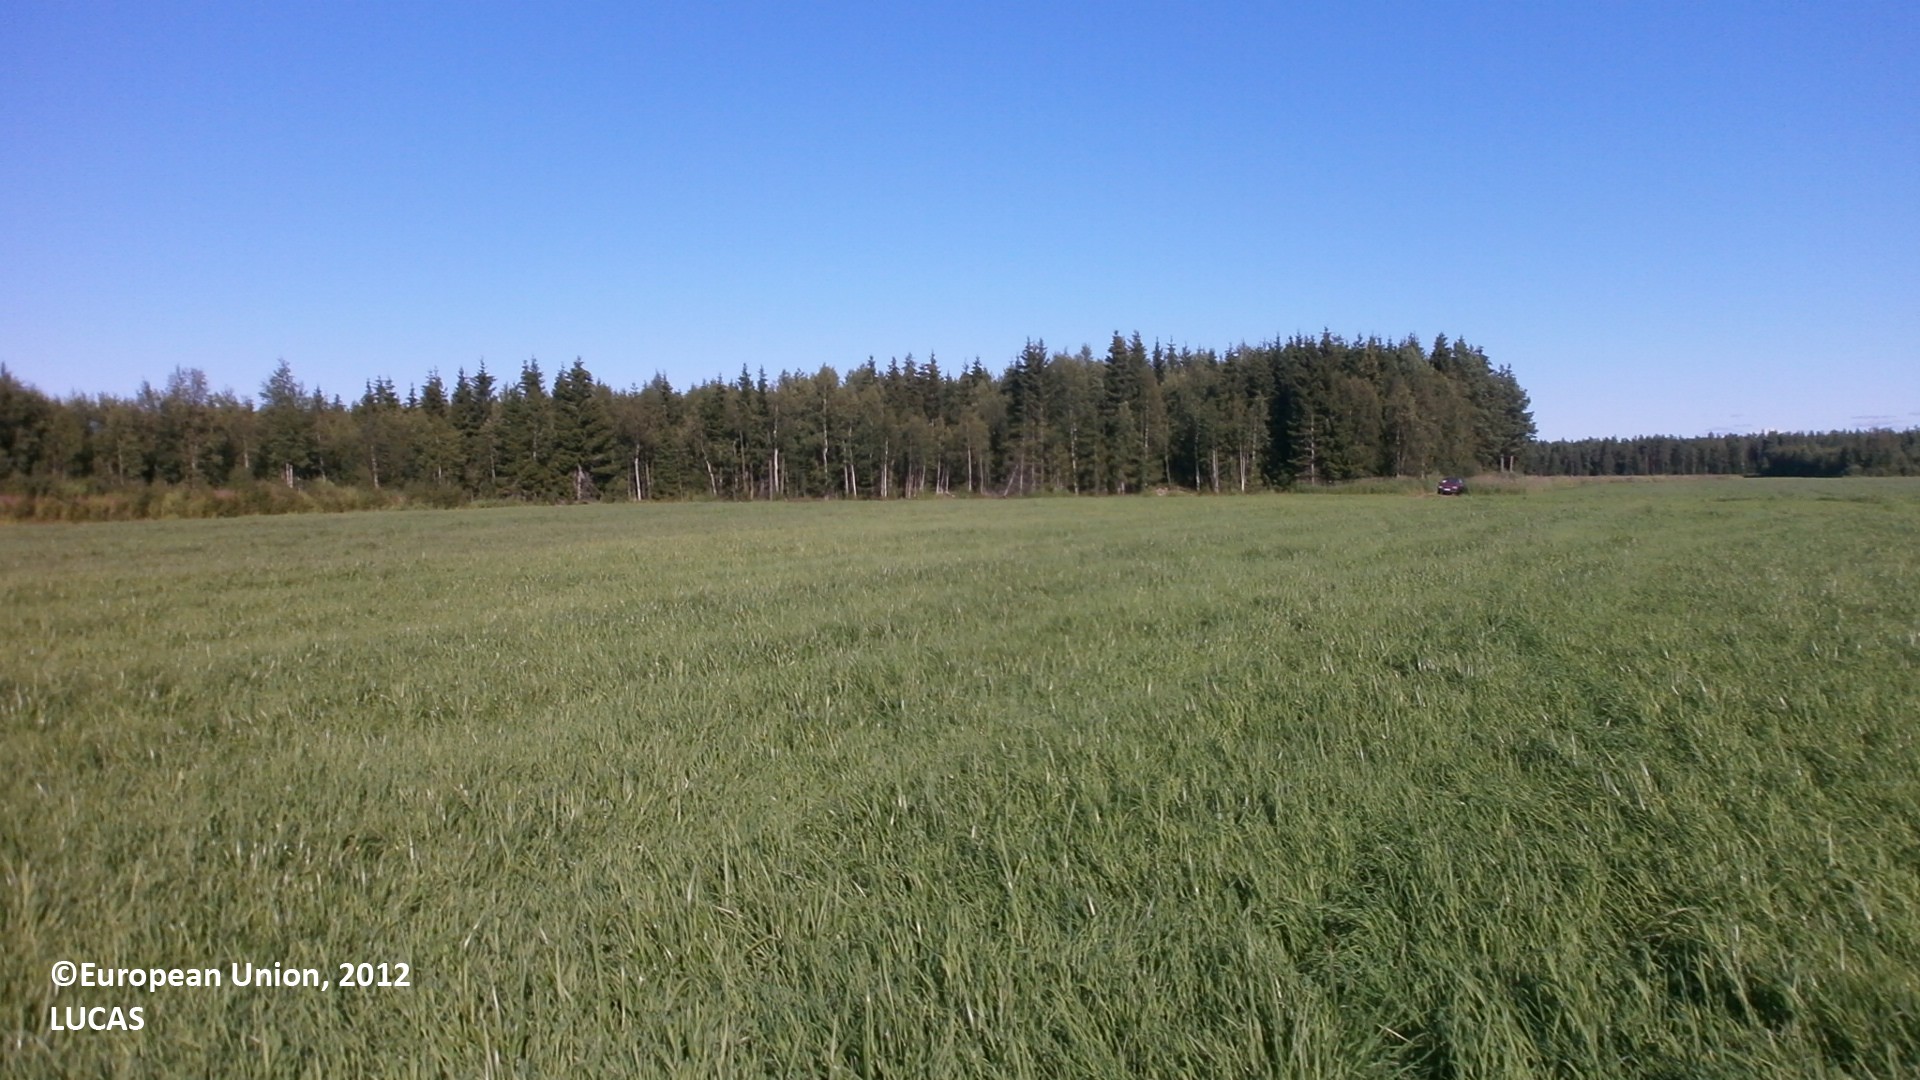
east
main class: Cropland
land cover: Temporary grasslands
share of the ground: > 75 %
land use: Agriculture (excluding fallow land and kitchen gardens)
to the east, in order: Temporary grasslands; Shruby margins; Ditches and canals; Spruce dominated mixed woodland; Ditches and canals; Spruce dominated coniferous woodland; Tracks; Spruce dominated coniferous woodland
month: July
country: FI
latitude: 64.2178
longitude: 23.9719
